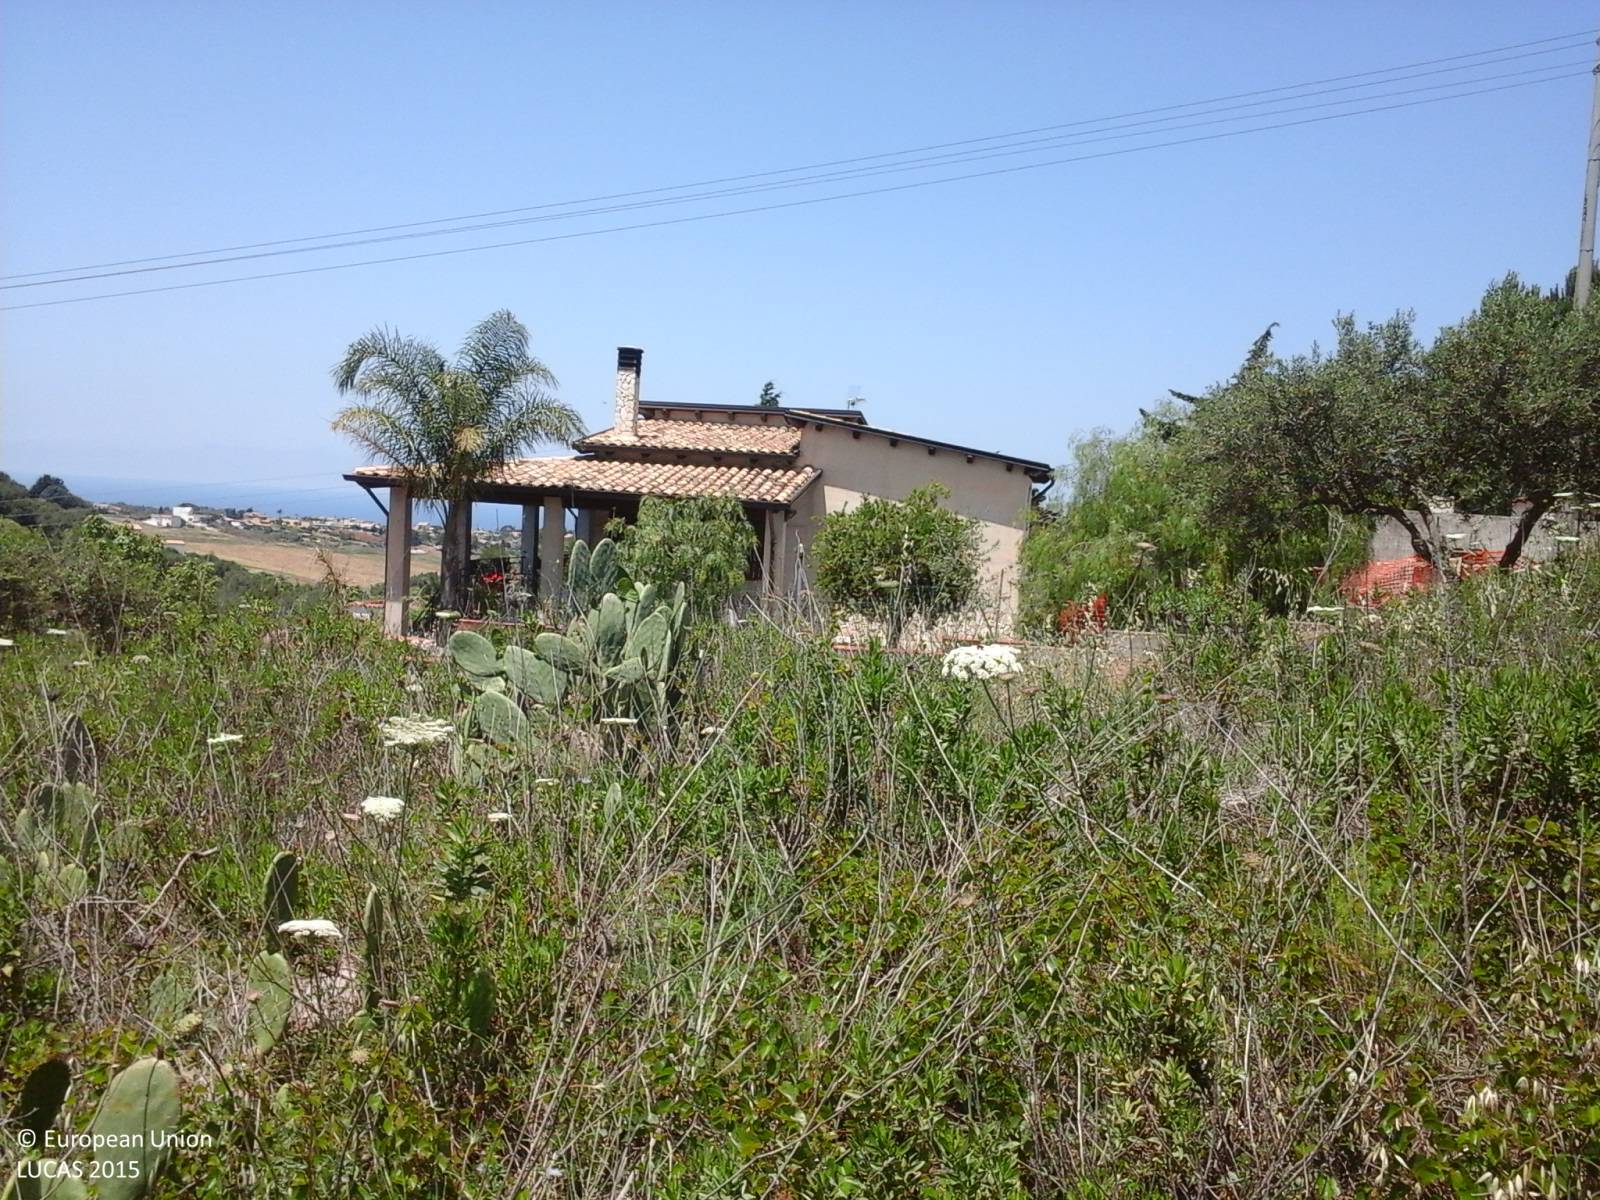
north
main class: Grassland
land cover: Grassland without tree/shrub cover
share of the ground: > 75 %
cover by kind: herbaceous plants 100 %
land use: Abandoned areas
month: June
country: IT
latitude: 37.9924
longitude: 12.9507
